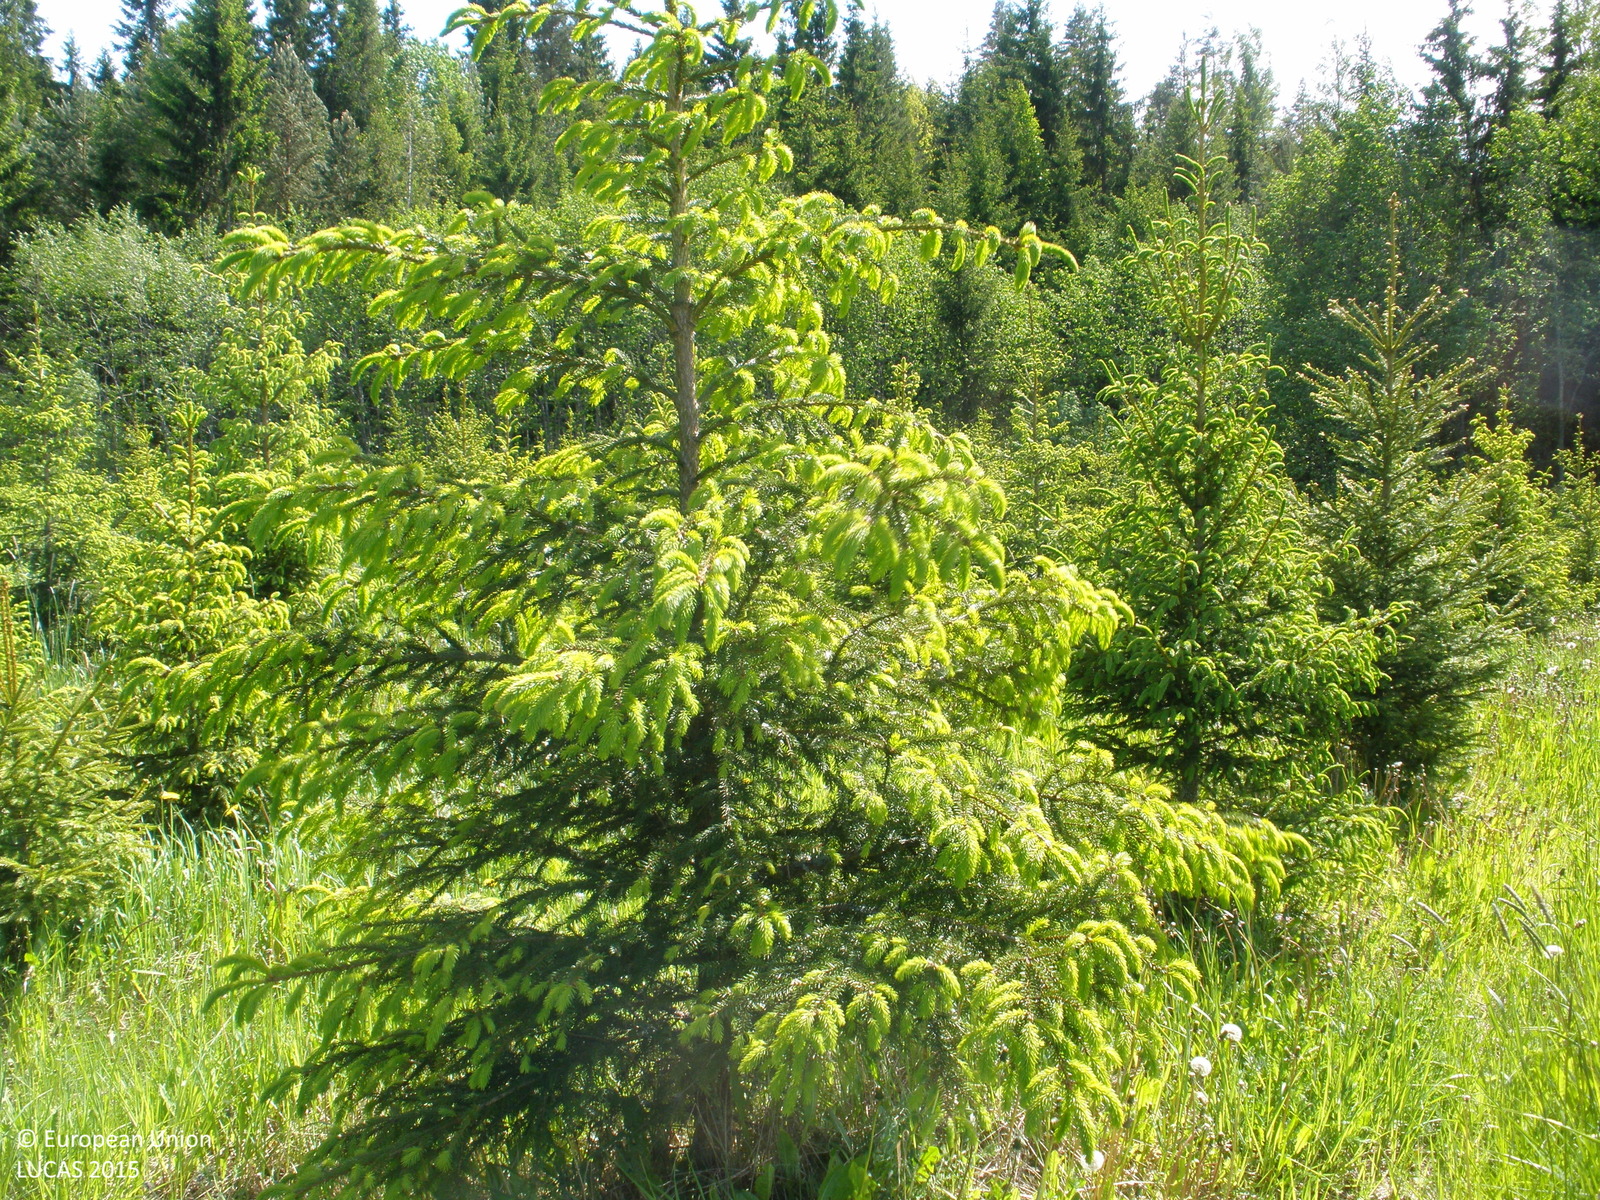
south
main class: Woodland
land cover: Spruce dominated coniferous woodland
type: boreal forest
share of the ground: 25 - 50 %
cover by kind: herbaceous plants 65 %, coniferous forest trees 35 %
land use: Forestry
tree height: < 5 m
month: June
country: FI
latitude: 60.7193
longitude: 23.4836
